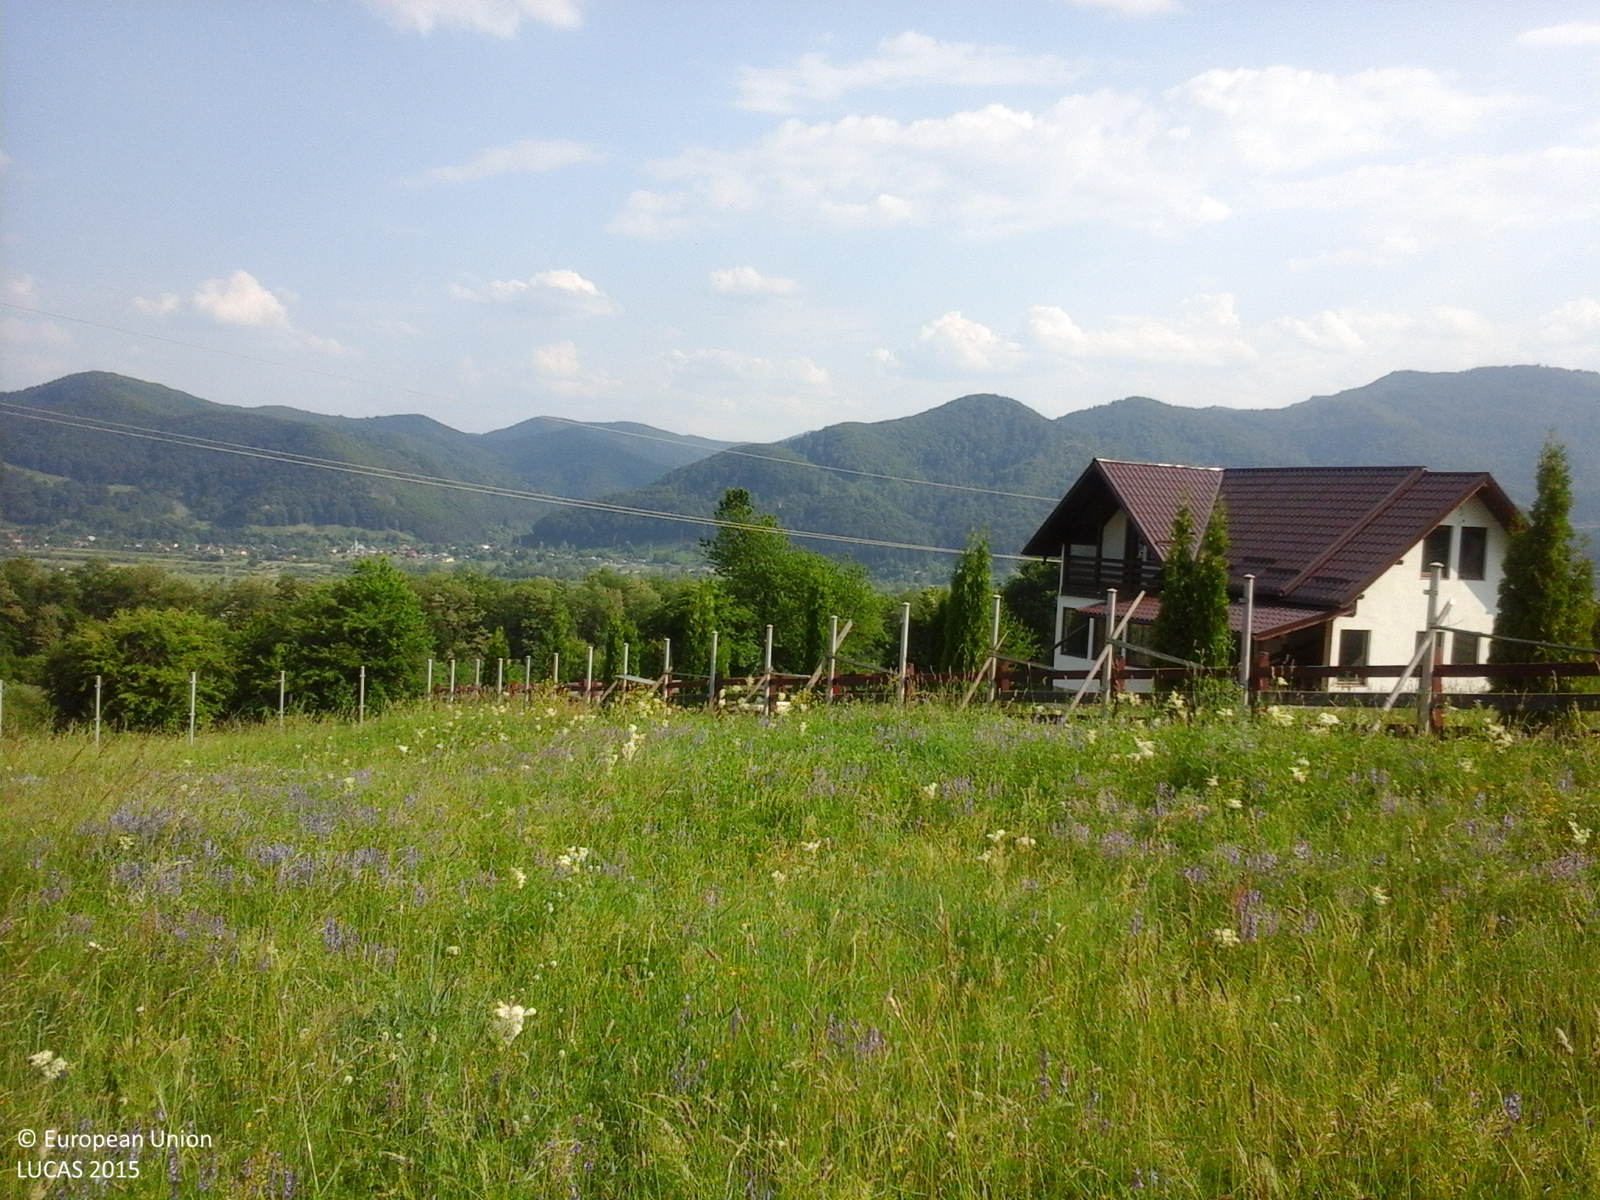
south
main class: Cropland
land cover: Other leguminous and mixtures for fodder
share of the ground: > 75 %
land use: Agriculture (excluding fallow land and kitchen gardens)
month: June
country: RO
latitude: 46.9477
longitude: 26.2788
